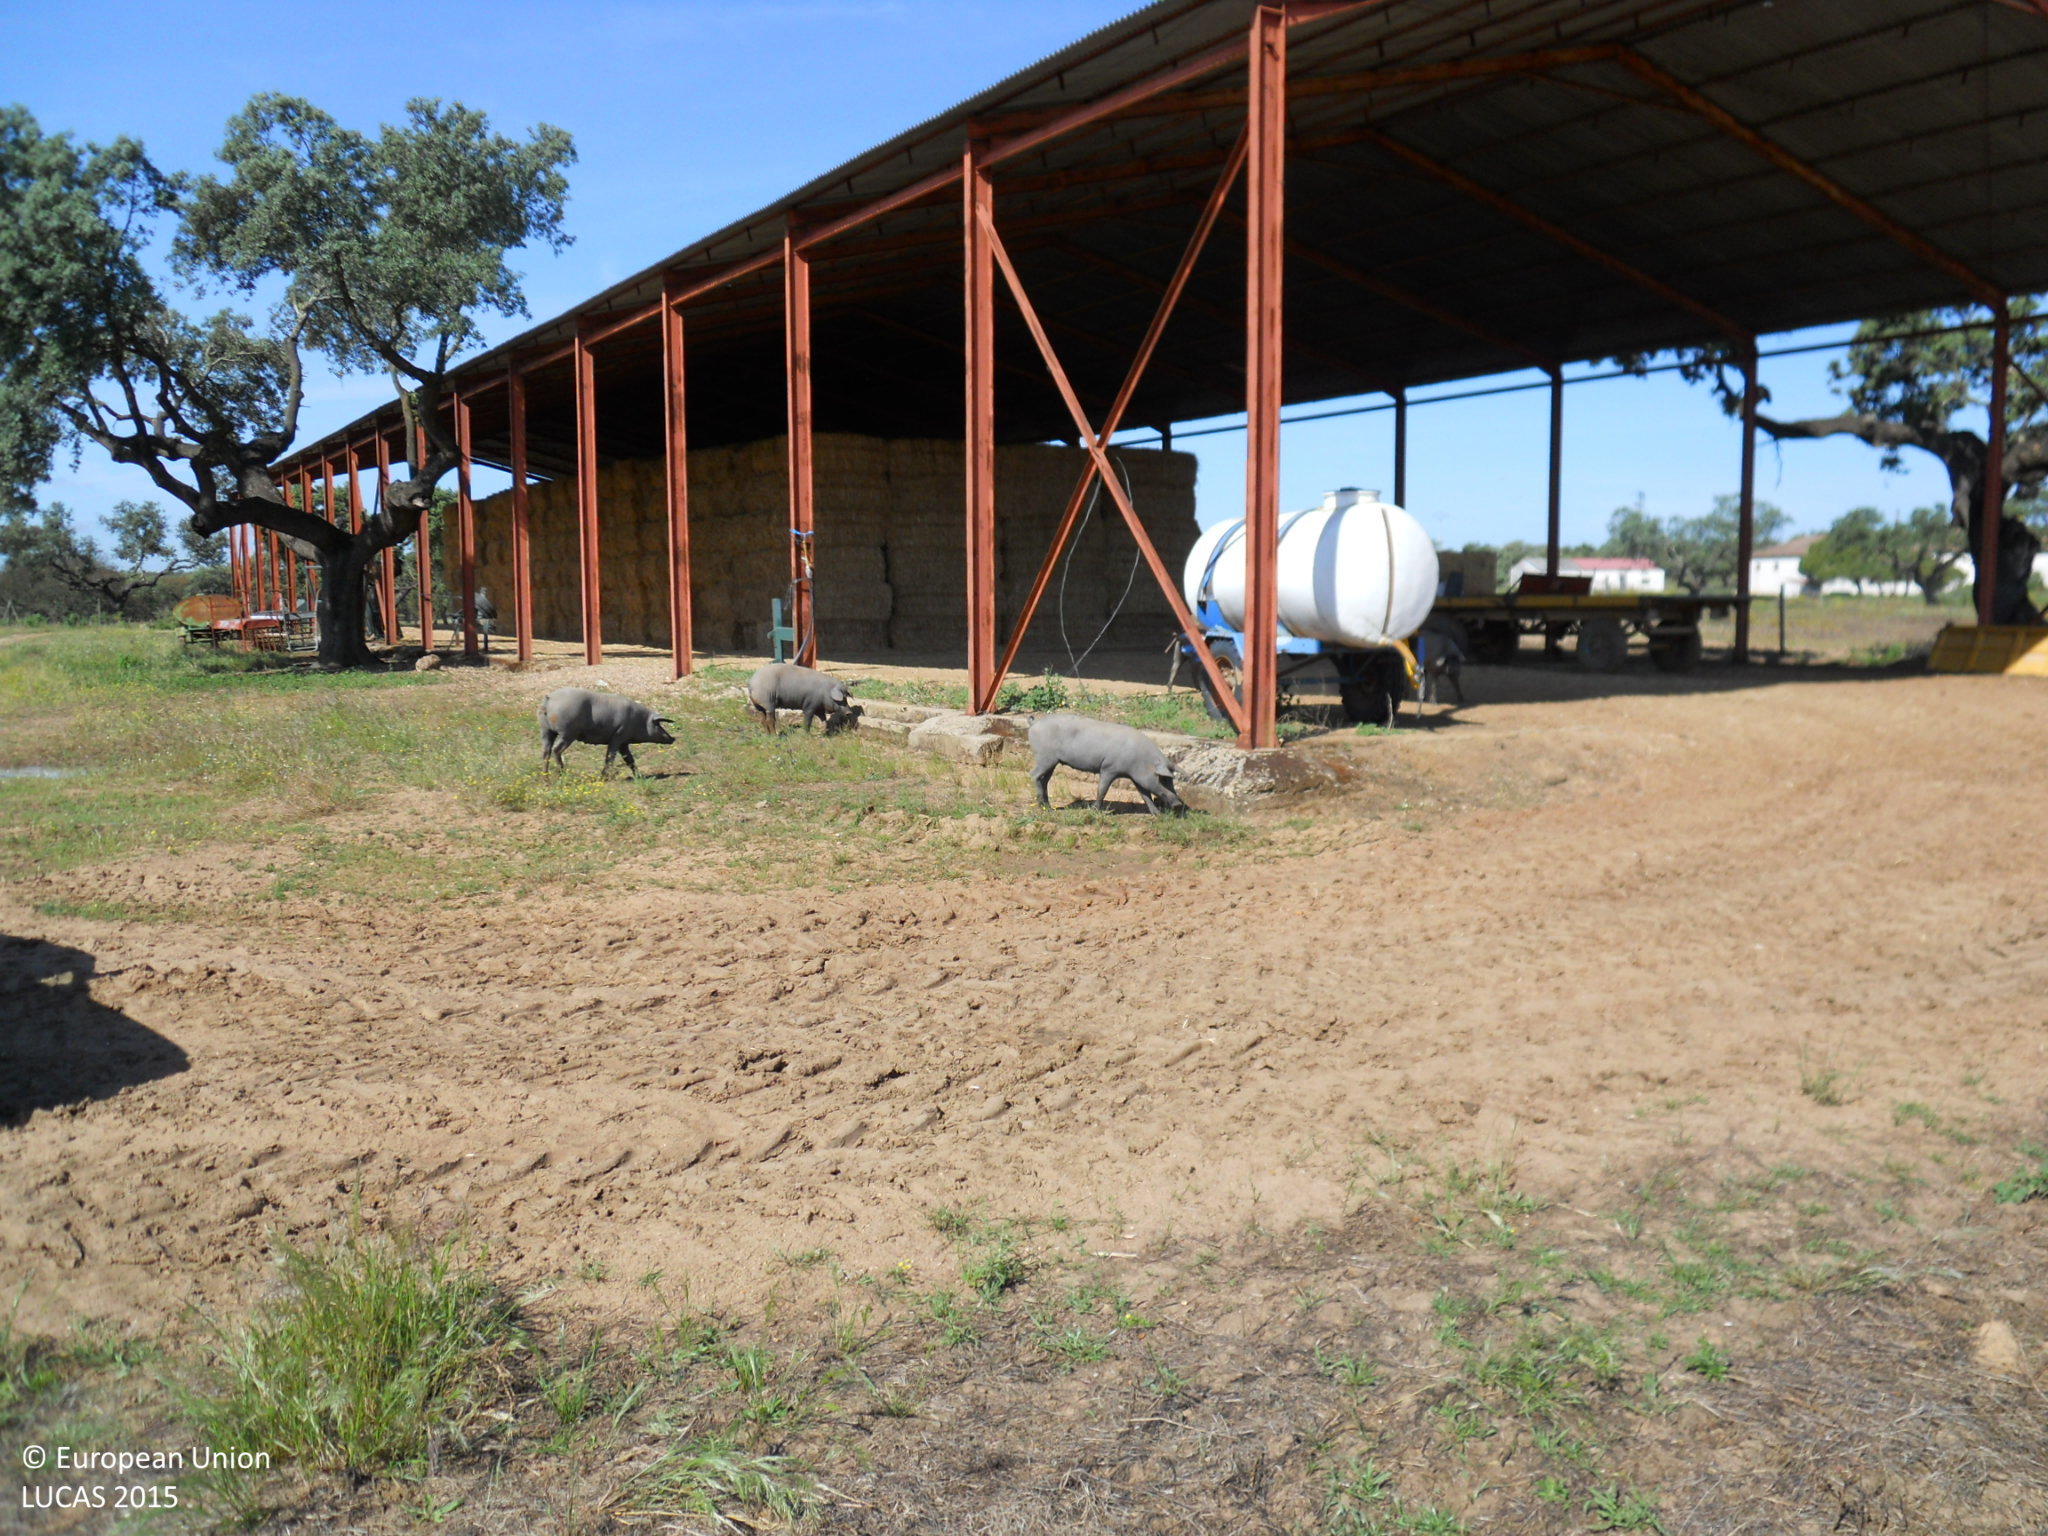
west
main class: Cropland
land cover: Sunflower
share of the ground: < 10 %
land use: Agriculture (excluding fallow land and kitchen gardens)
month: April
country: ES
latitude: 39.0407
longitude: -6.8337
